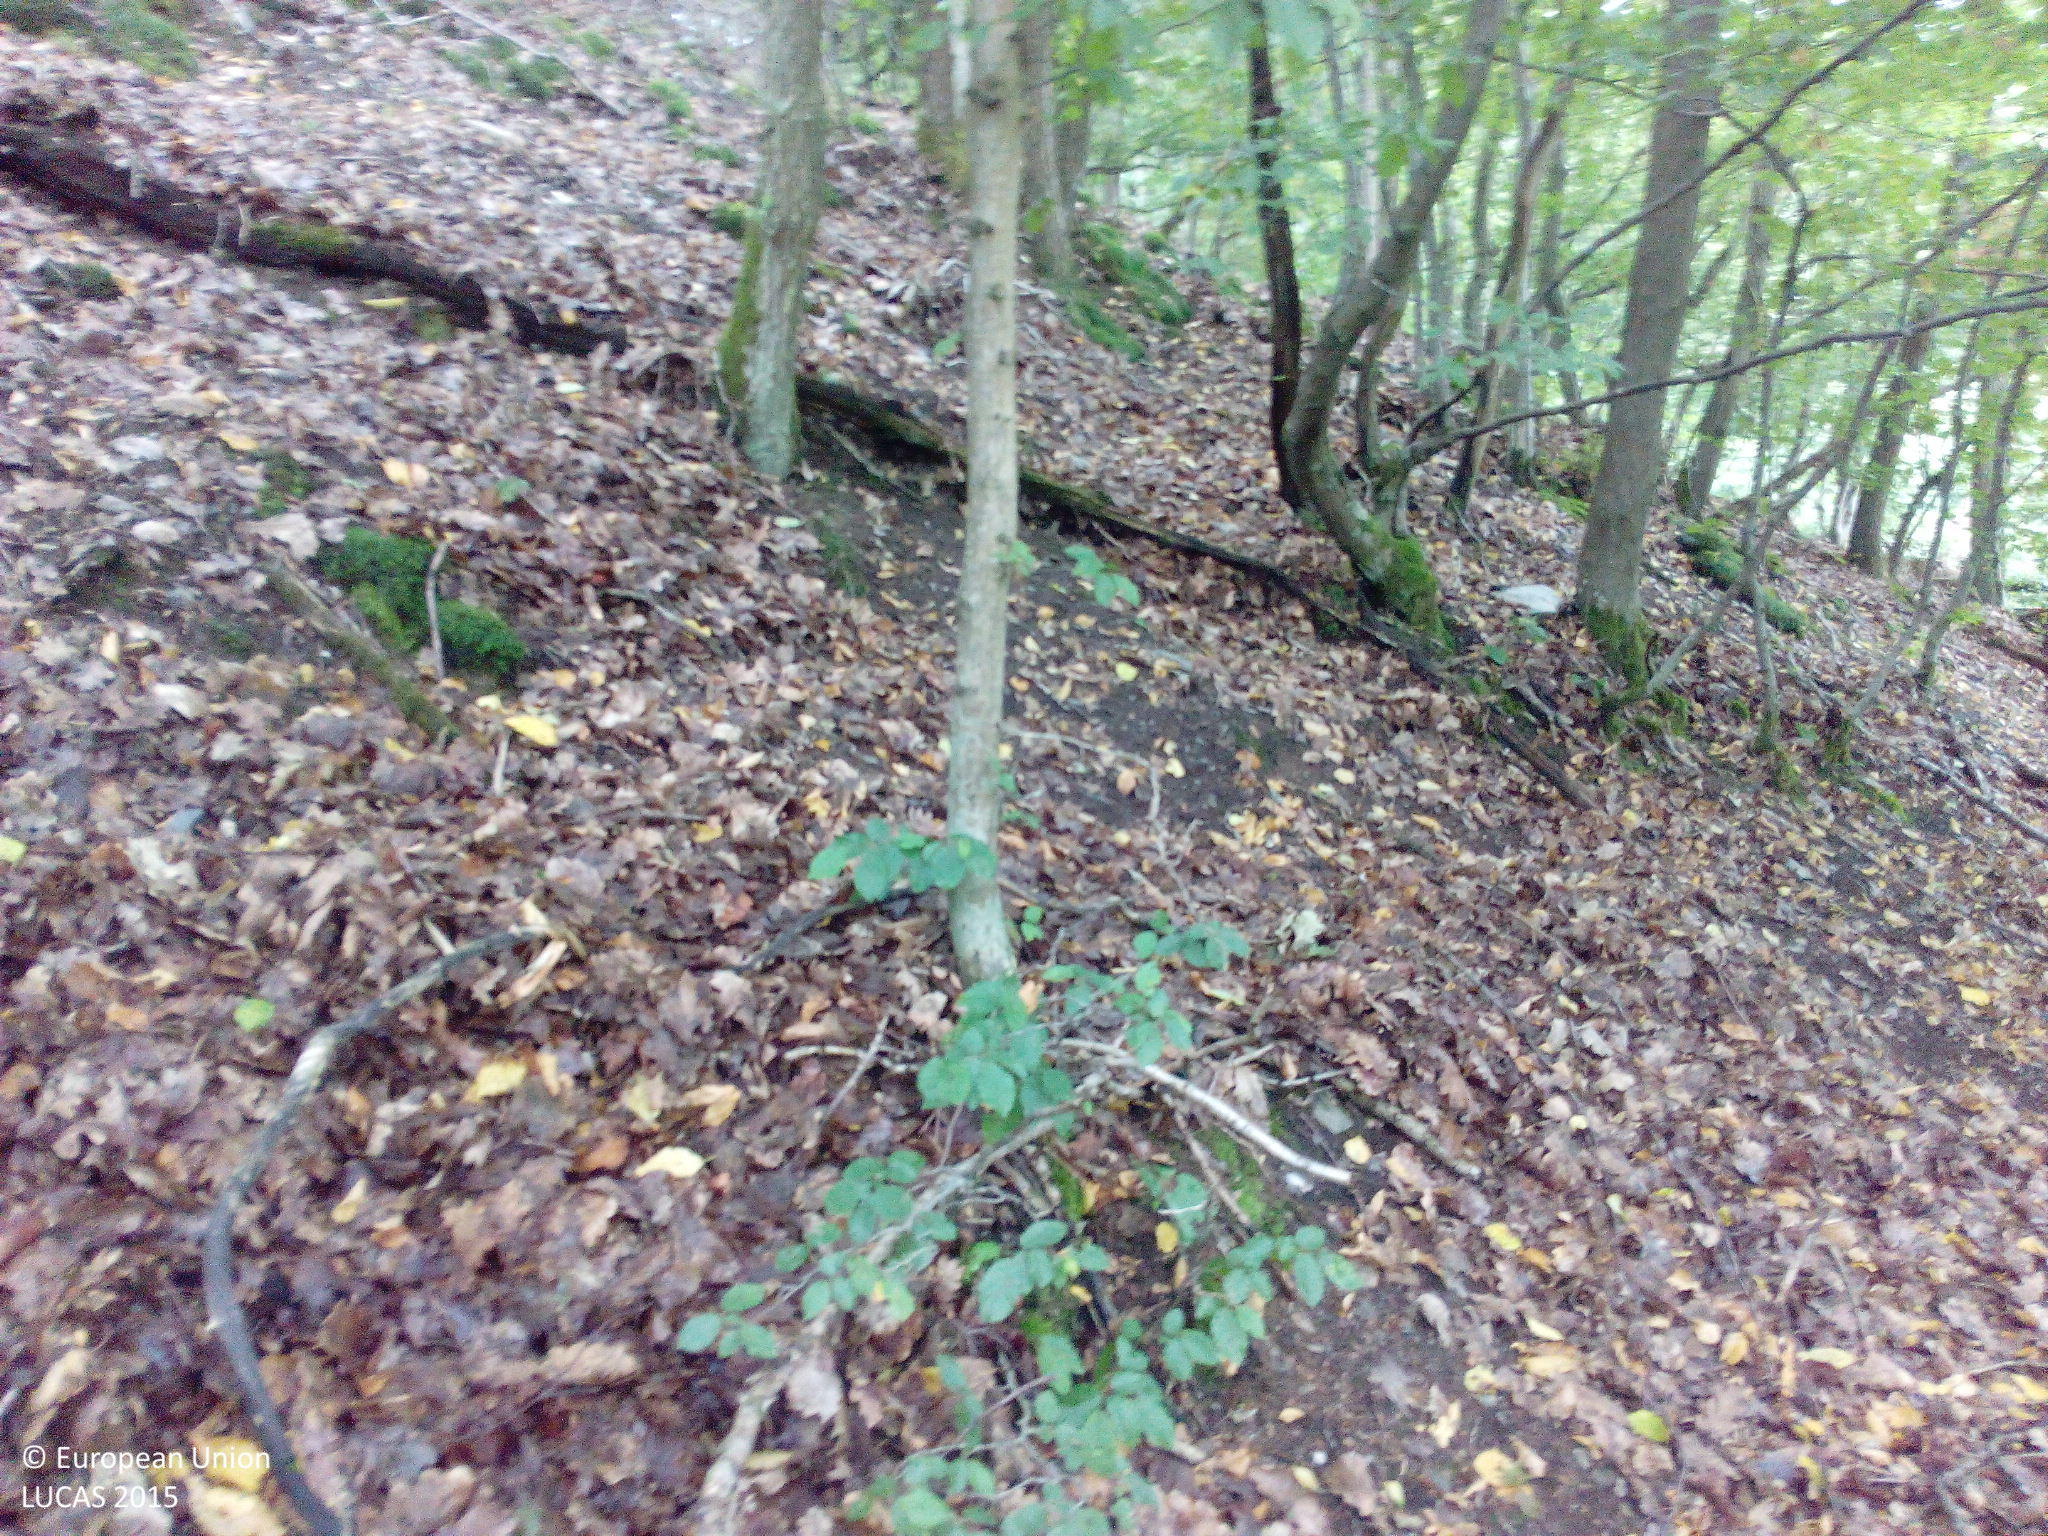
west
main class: Woodland
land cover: Broadleaved woodland
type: mesophytic deciduous forest
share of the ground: > 75 %
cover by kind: broadleaved forest trees 100 %
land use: Forestry
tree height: > 5 m
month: July
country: DE
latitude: 49.9858
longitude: 7.1131
